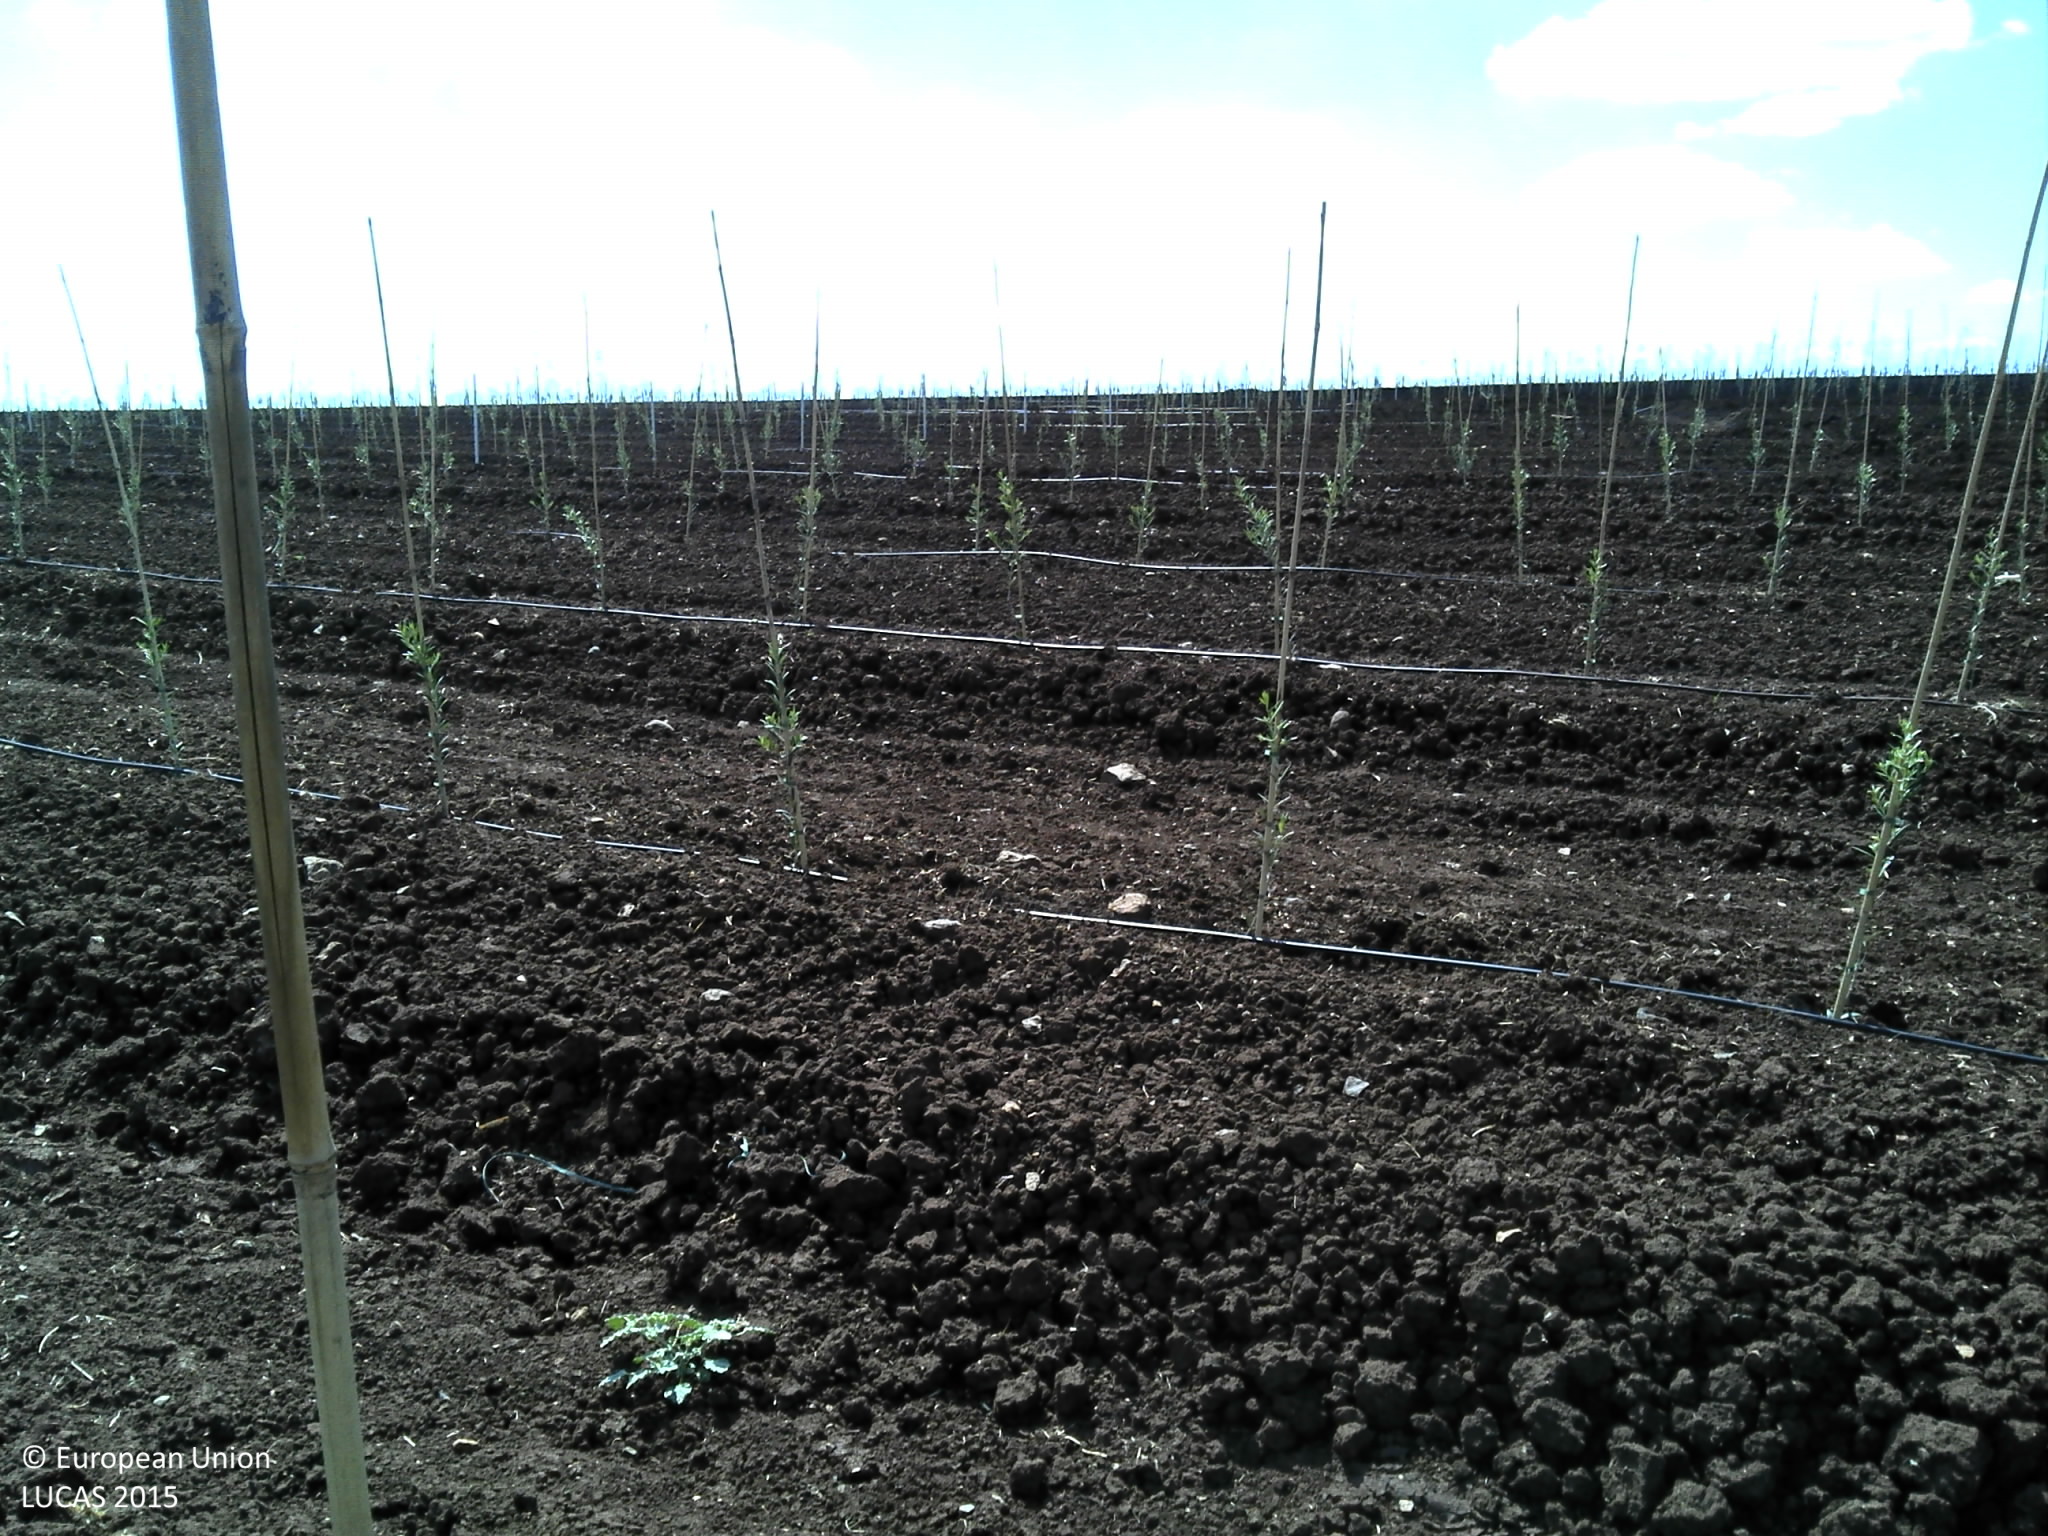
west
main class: Cropland
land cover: Olive groves
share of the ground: 10 - 25 %
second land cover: Other bare soil
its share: > 75 %
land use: Agriculture (excluding fallow land and kitchen gardens)
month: July
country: PT
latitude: 37.9993
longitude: -7.6858
